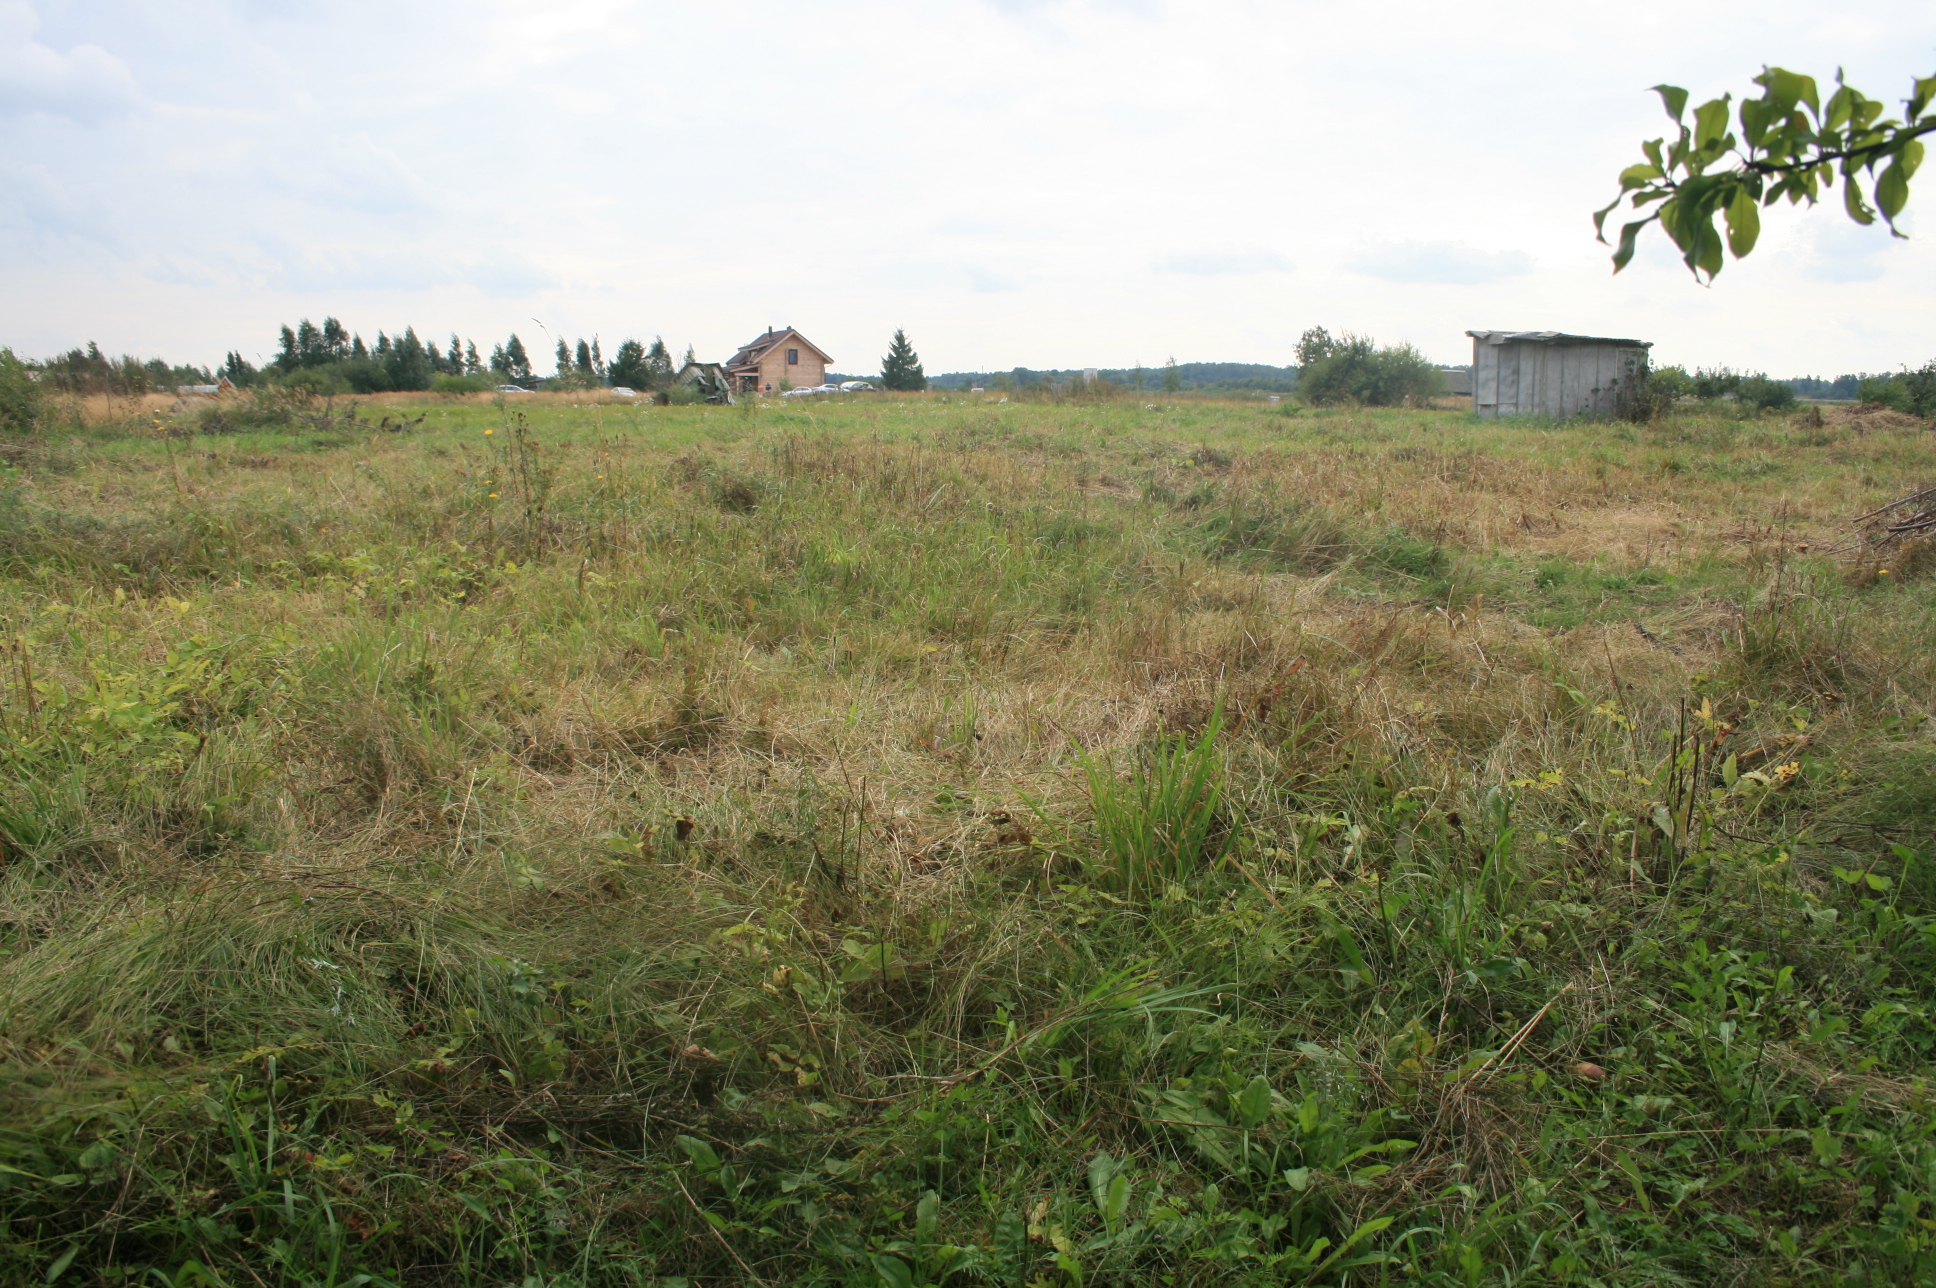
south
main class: Cropland
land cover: Apple fruit
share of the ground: 50 - 75 %
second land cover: Grassland without tree/shrub cover
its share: > 75 %
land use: Kitchen garden
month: September
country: LT
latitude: 55.7028
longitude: 21.3249
